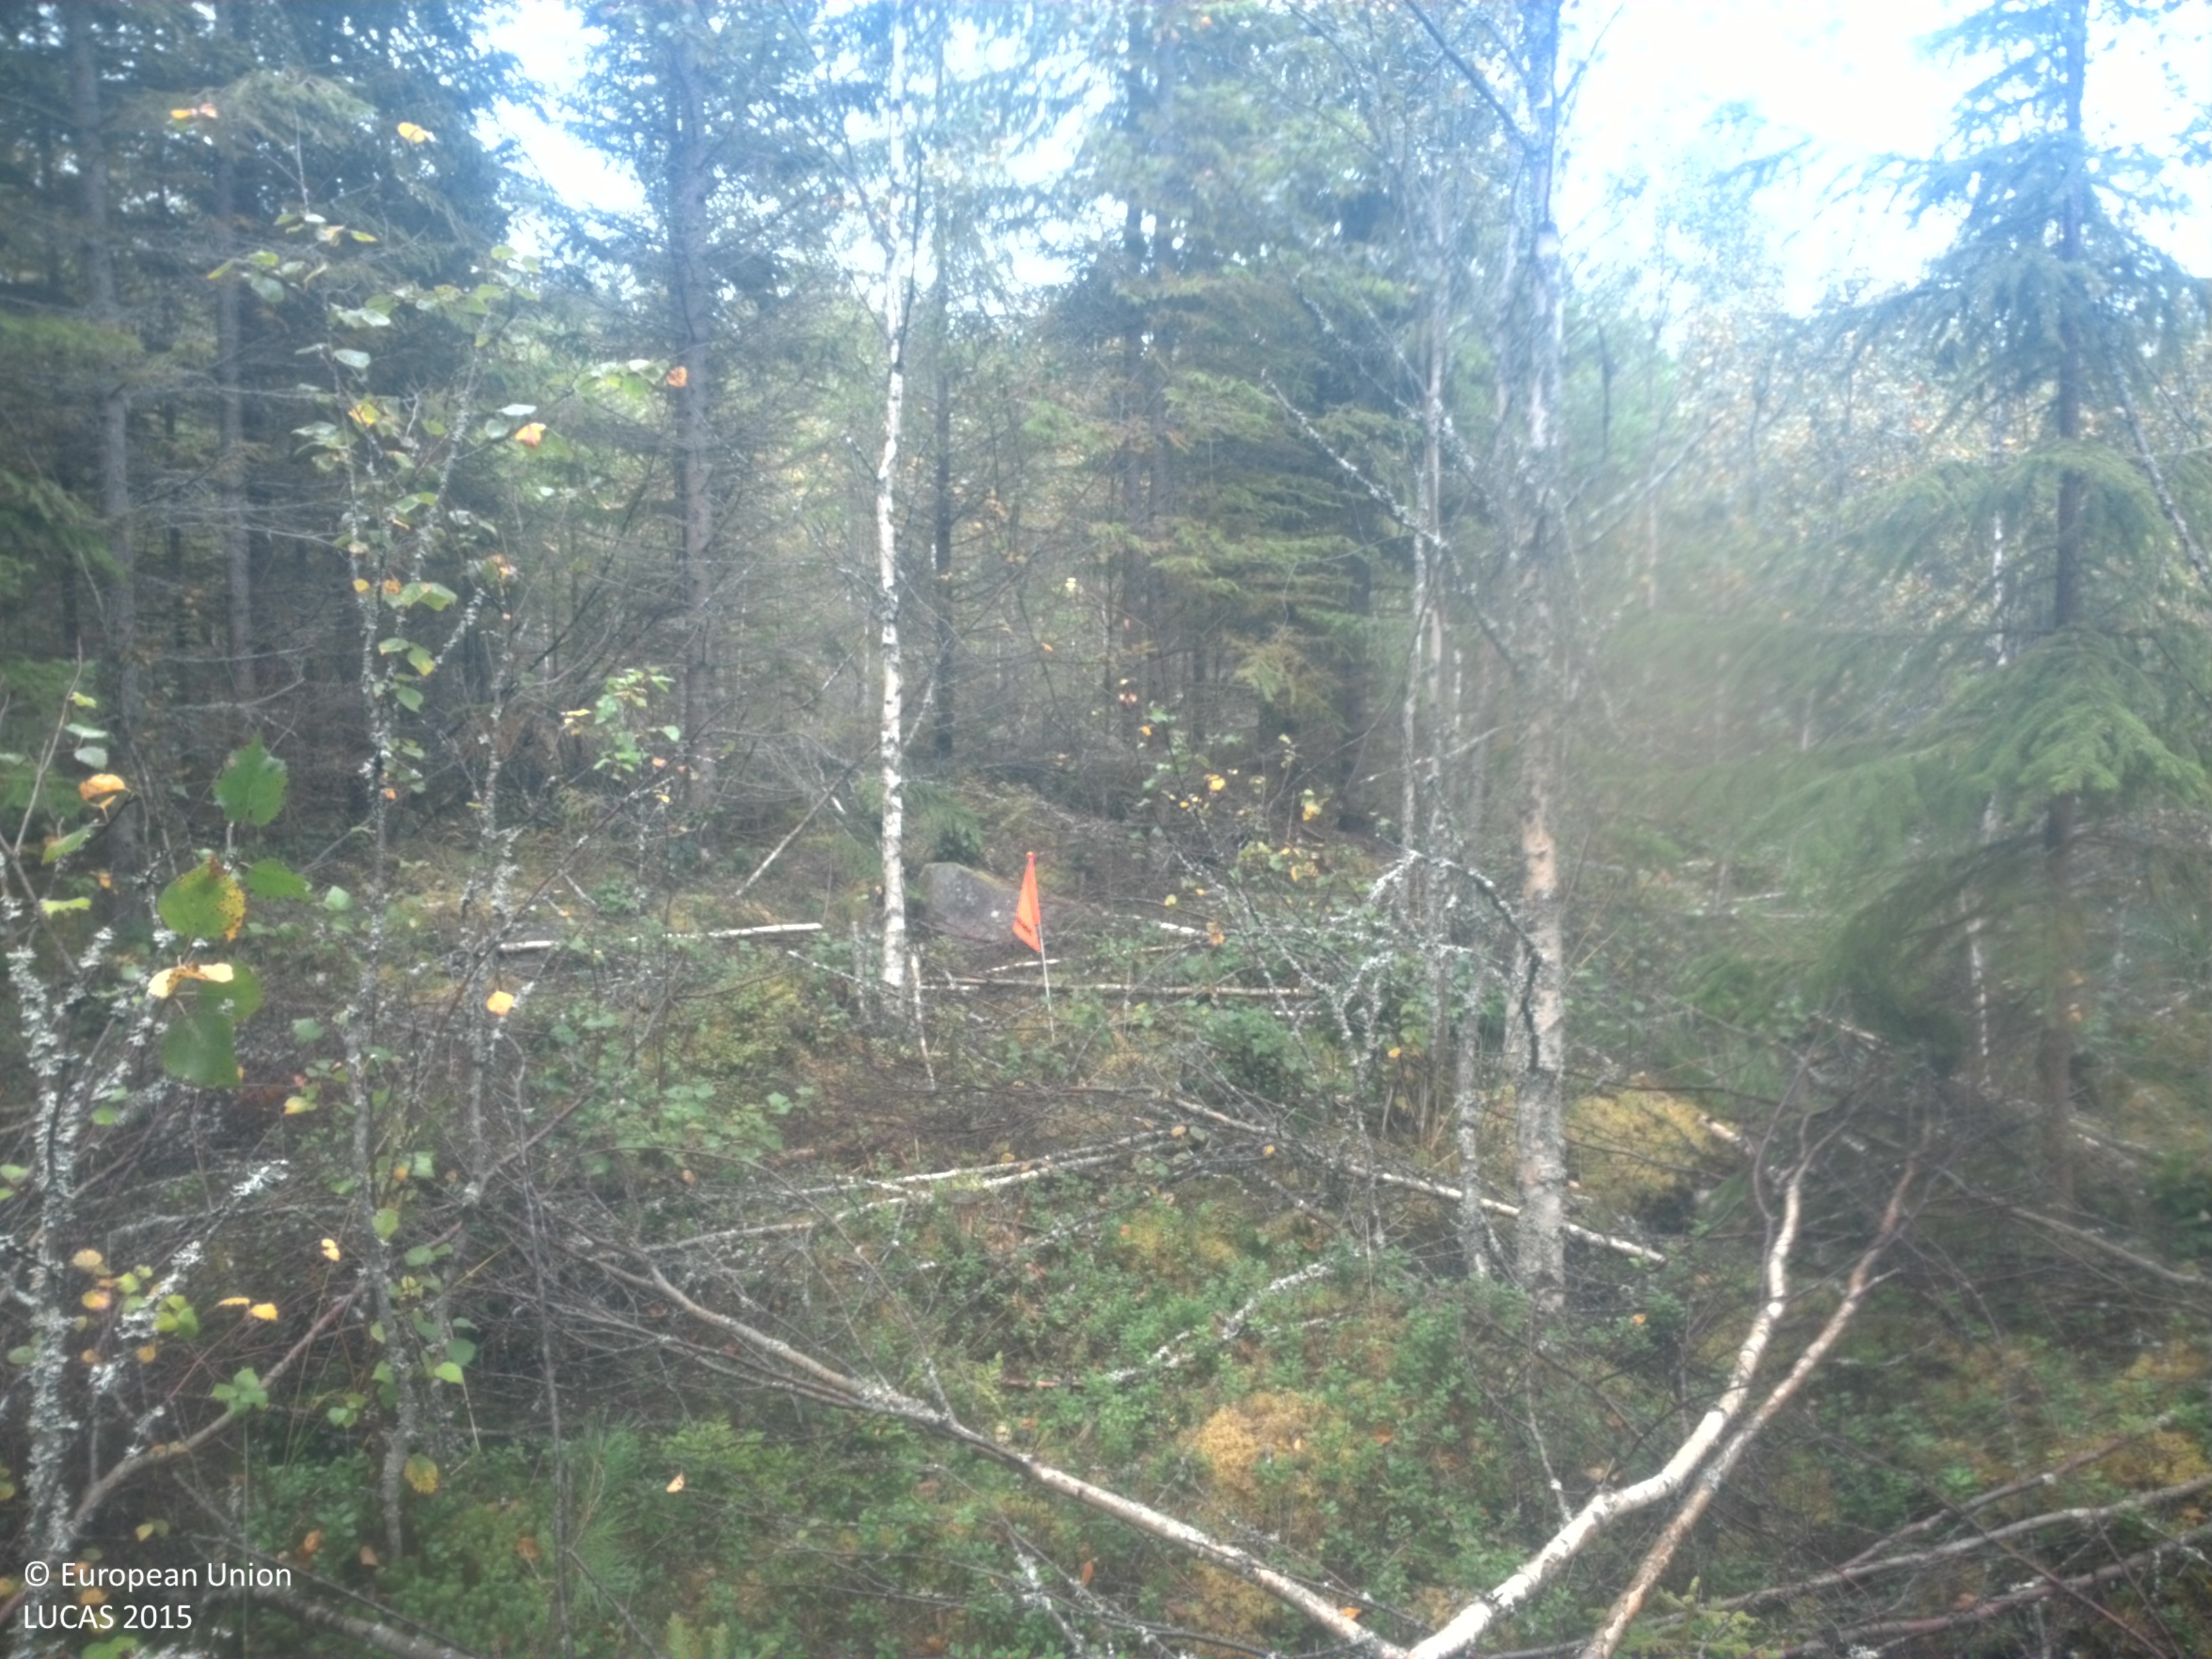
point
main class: Woodland
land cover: Spruce dominated mixed woodland
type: boreal forest
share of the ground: 50 - 75 %
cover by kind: coniferous forest trees 30 %, broadleaved forest trees 20 %, shrubs 20 %, lichens and mosses 20 %, herbaceous plants 10 %
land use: Forestry
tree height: > 5 m
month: September
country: SE
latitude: 58.8795
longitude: 14.0345
